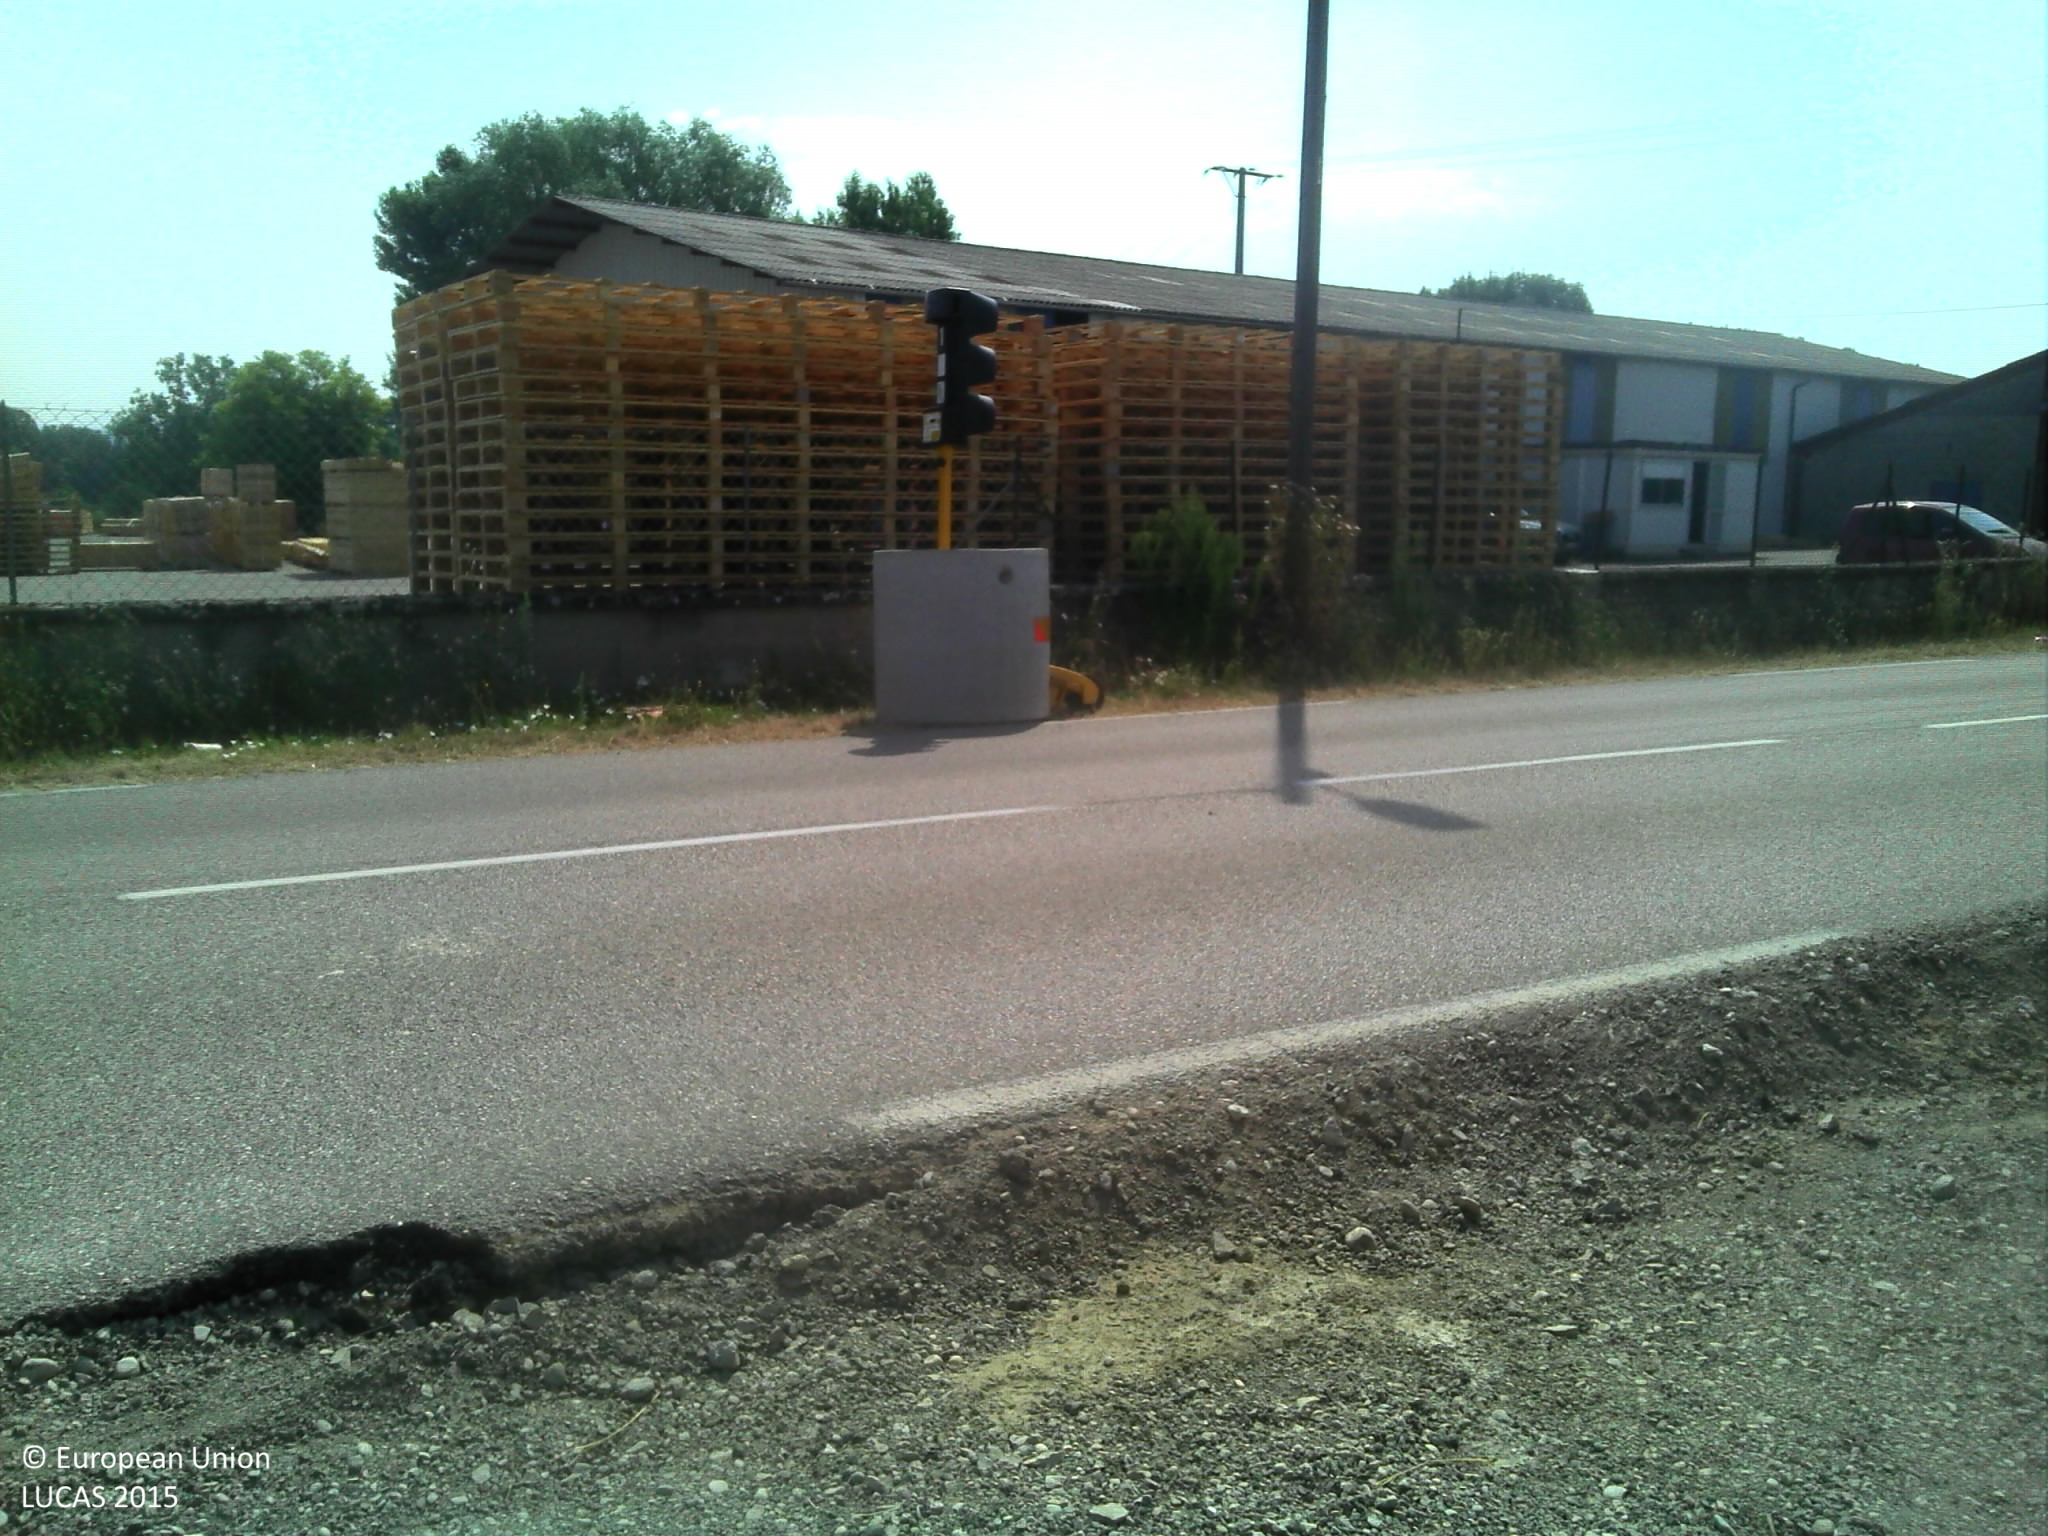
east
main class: Cropland
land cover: Durum wheat
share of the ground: > 75 %
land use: Agriculture (excluding fallow land and kitchen gardens)
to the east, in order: Durum wheat; Electric lines; Paved roads, cycling and walking lanes; Electric lines; Artificial constructions in urban areas; Lines of trees; Grassland with sparse tree/shrub cover; Electric lines; Grassland without tree/shrub cover; Dry stone walls; Grassland without tree/shrub cover
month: July
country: FR
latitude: 45.7735
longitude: 5.1813
